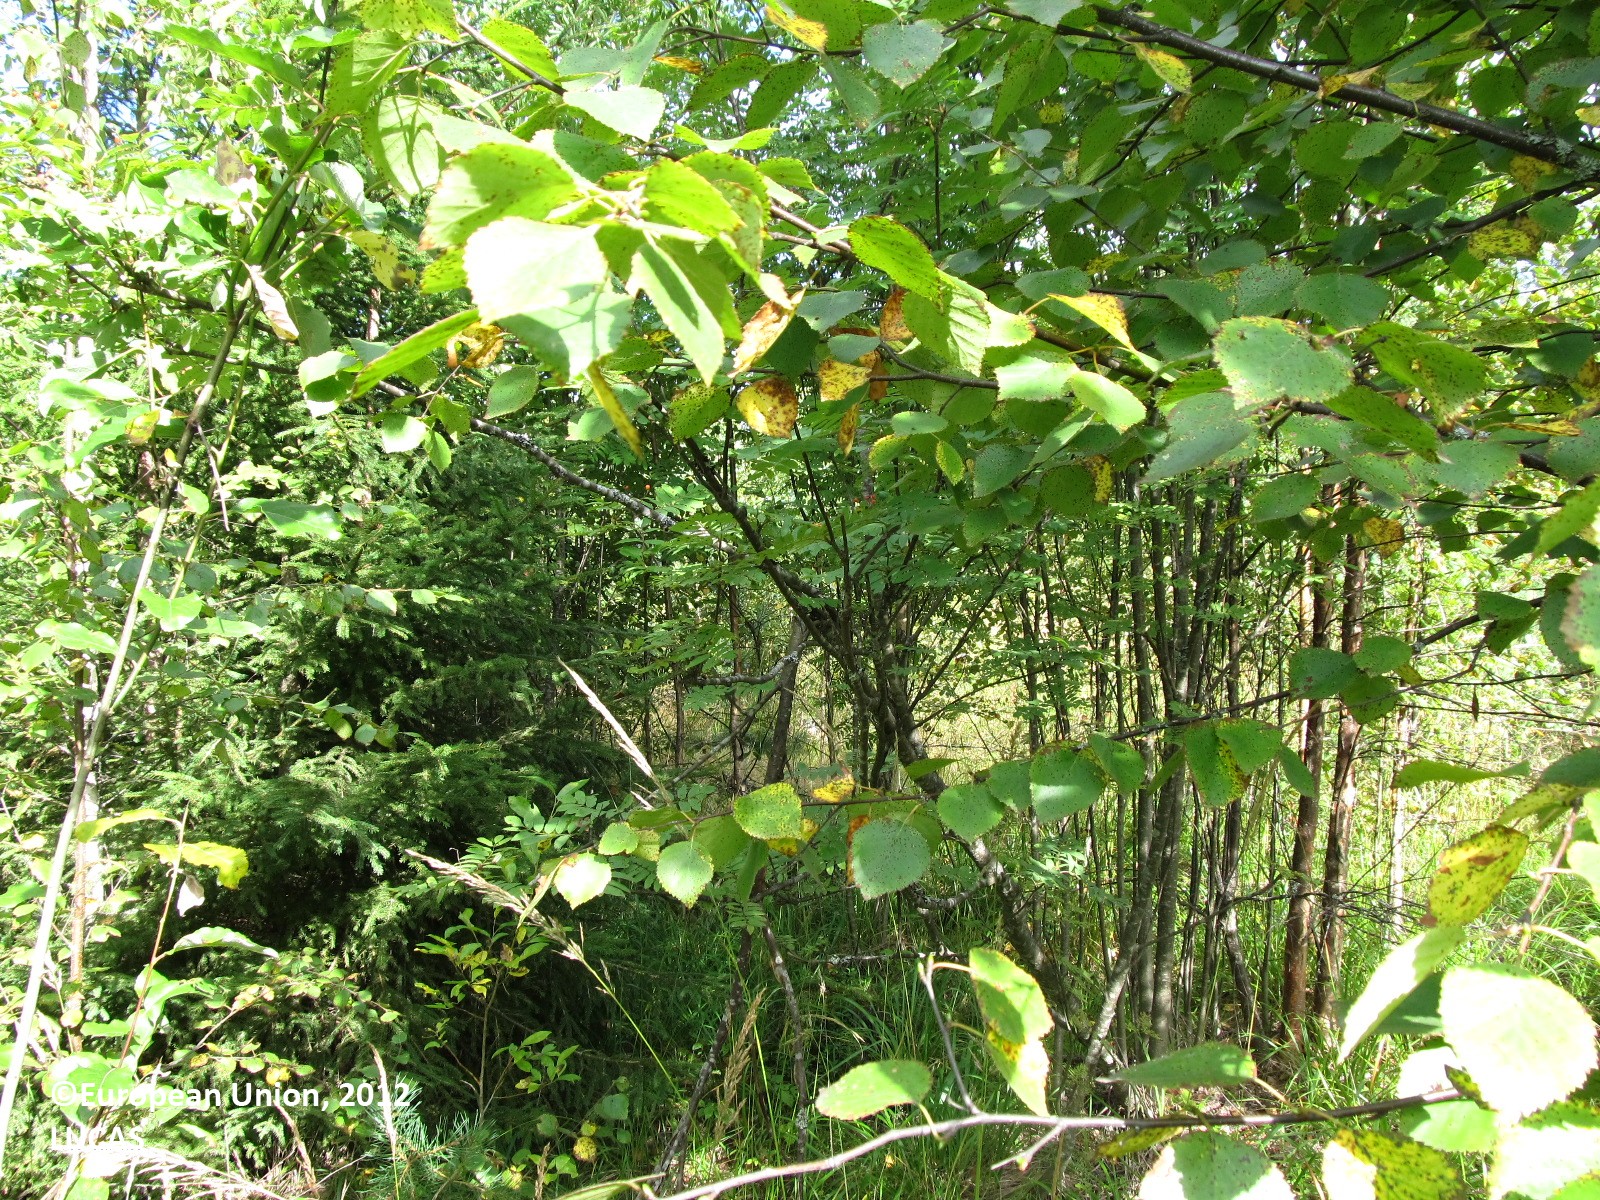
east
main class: Woodland
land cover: Broadleaved woodland
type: boreal forest
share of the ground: 50 - 75 %
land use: Forestry
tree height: < 5 m
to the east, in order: Broadleaved woodland; Spruce dominated coniferous woodland; Ditches and canals; Spruce dominated coniferous woodland
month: August
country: FI
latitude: 62.0150
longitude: 27.5384
